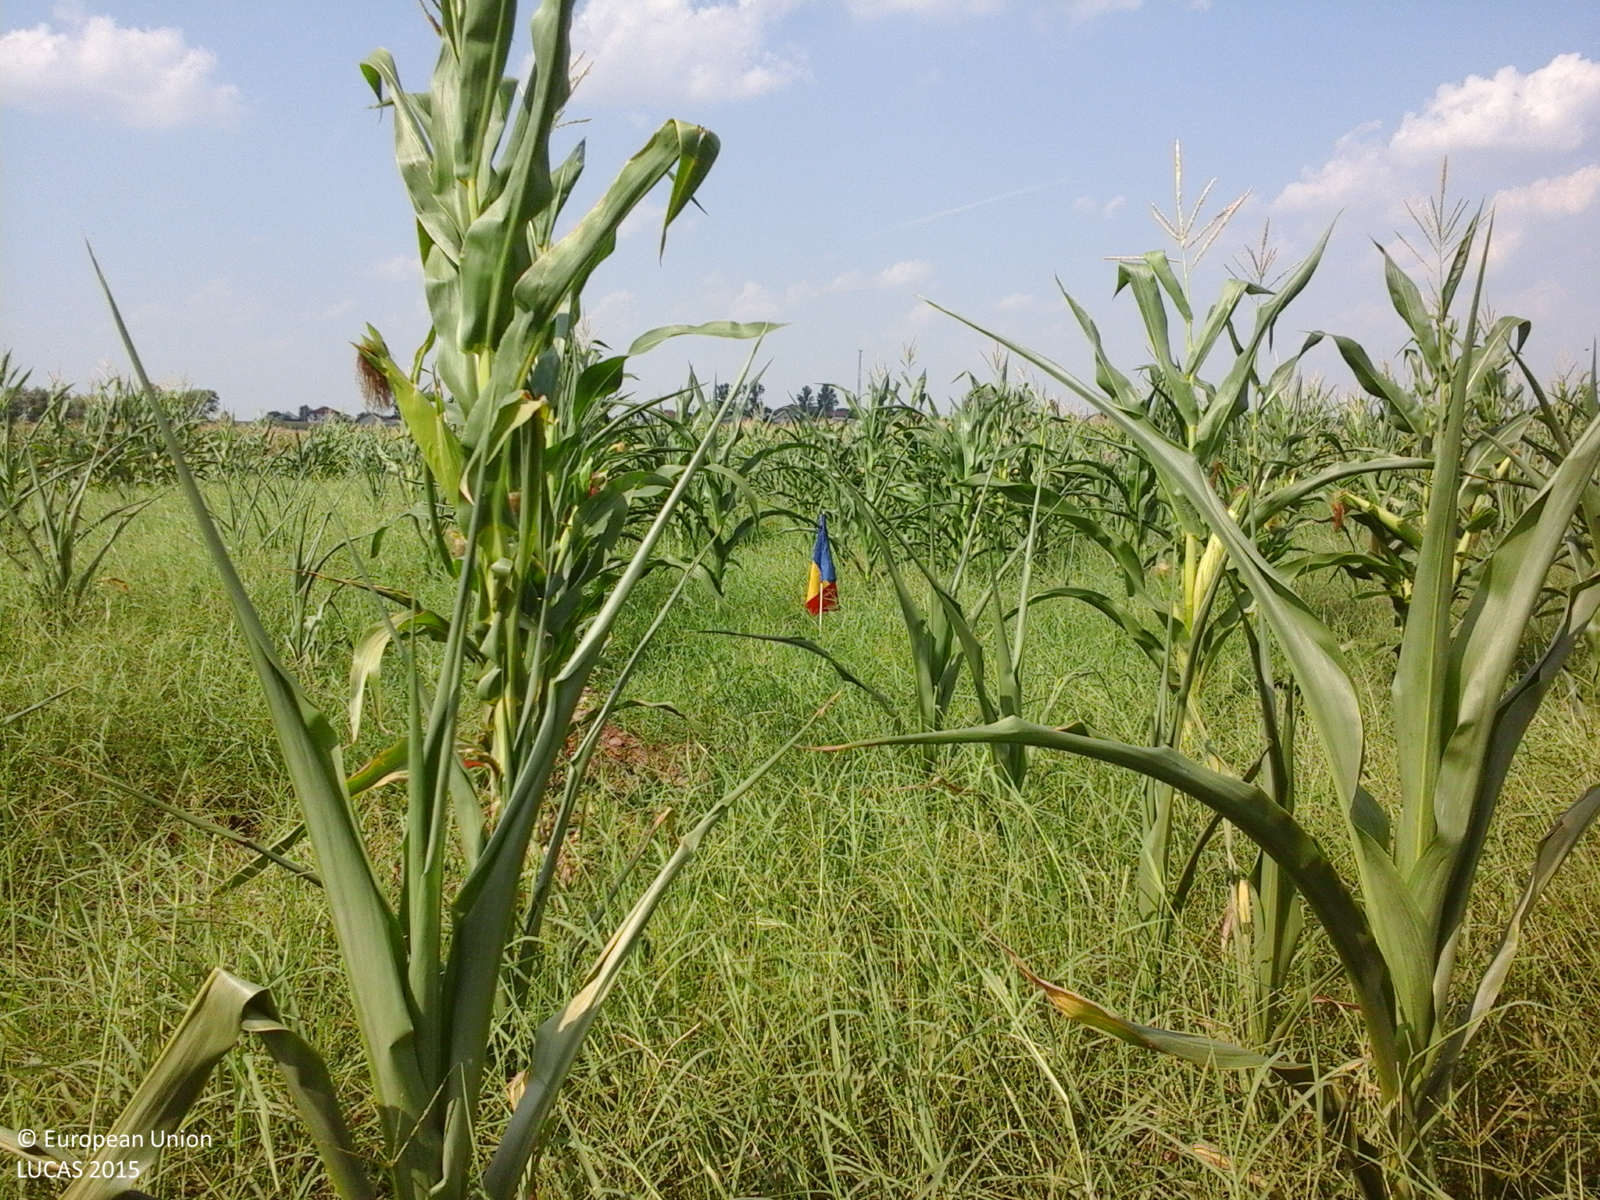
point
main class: Cropland
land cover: Maize
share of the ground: 50 - 75 %
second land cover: Spontaneously vegetated surfaces
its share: 25 - 50 %
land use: Agriculture (excluding fallow land and kitchen gardens)
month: July
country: RO
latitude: 45.8905
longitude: 27.5964
